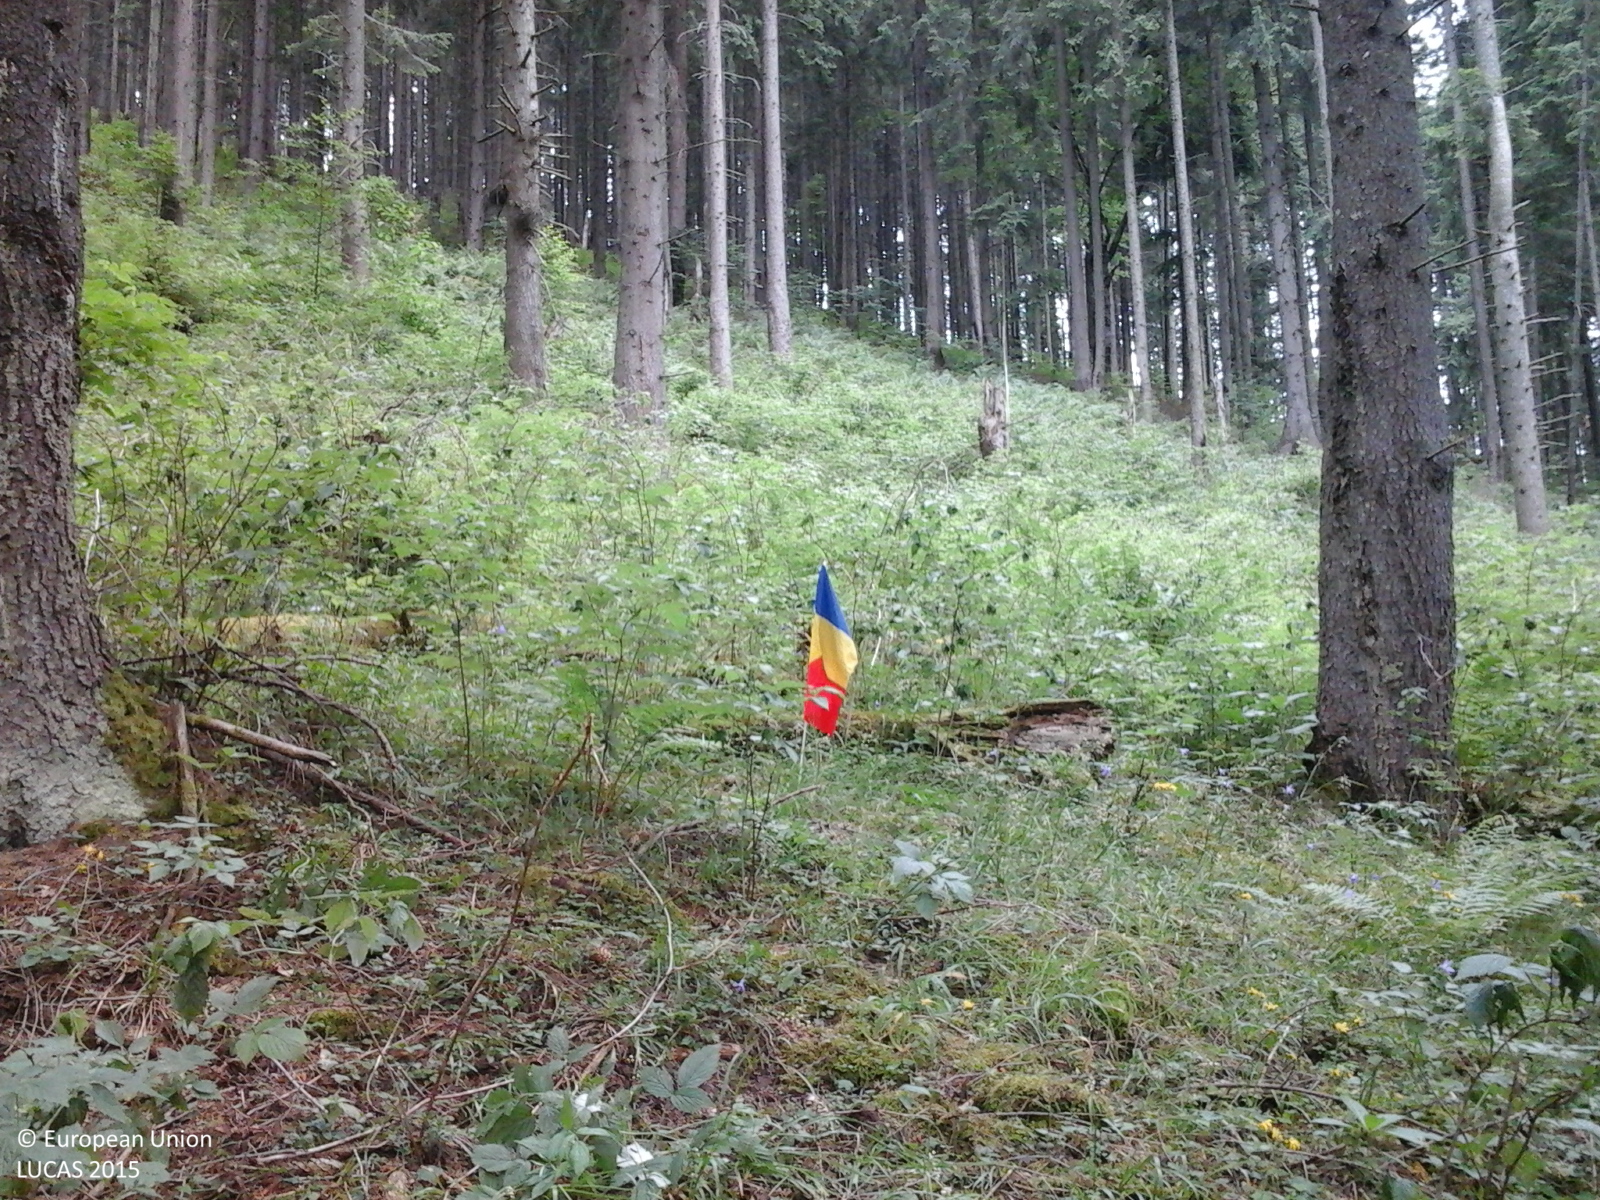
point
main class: Woodland
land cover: Spruce dominated coniferous woodland
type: alpine coniferous forest
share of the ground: > 75 %
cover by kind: coniferous forest trees 90 %, herbaceous plants 10 %
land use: Forestry
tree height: > 5 m
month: June
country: RO
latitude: 47.5667
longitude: 25.4408
